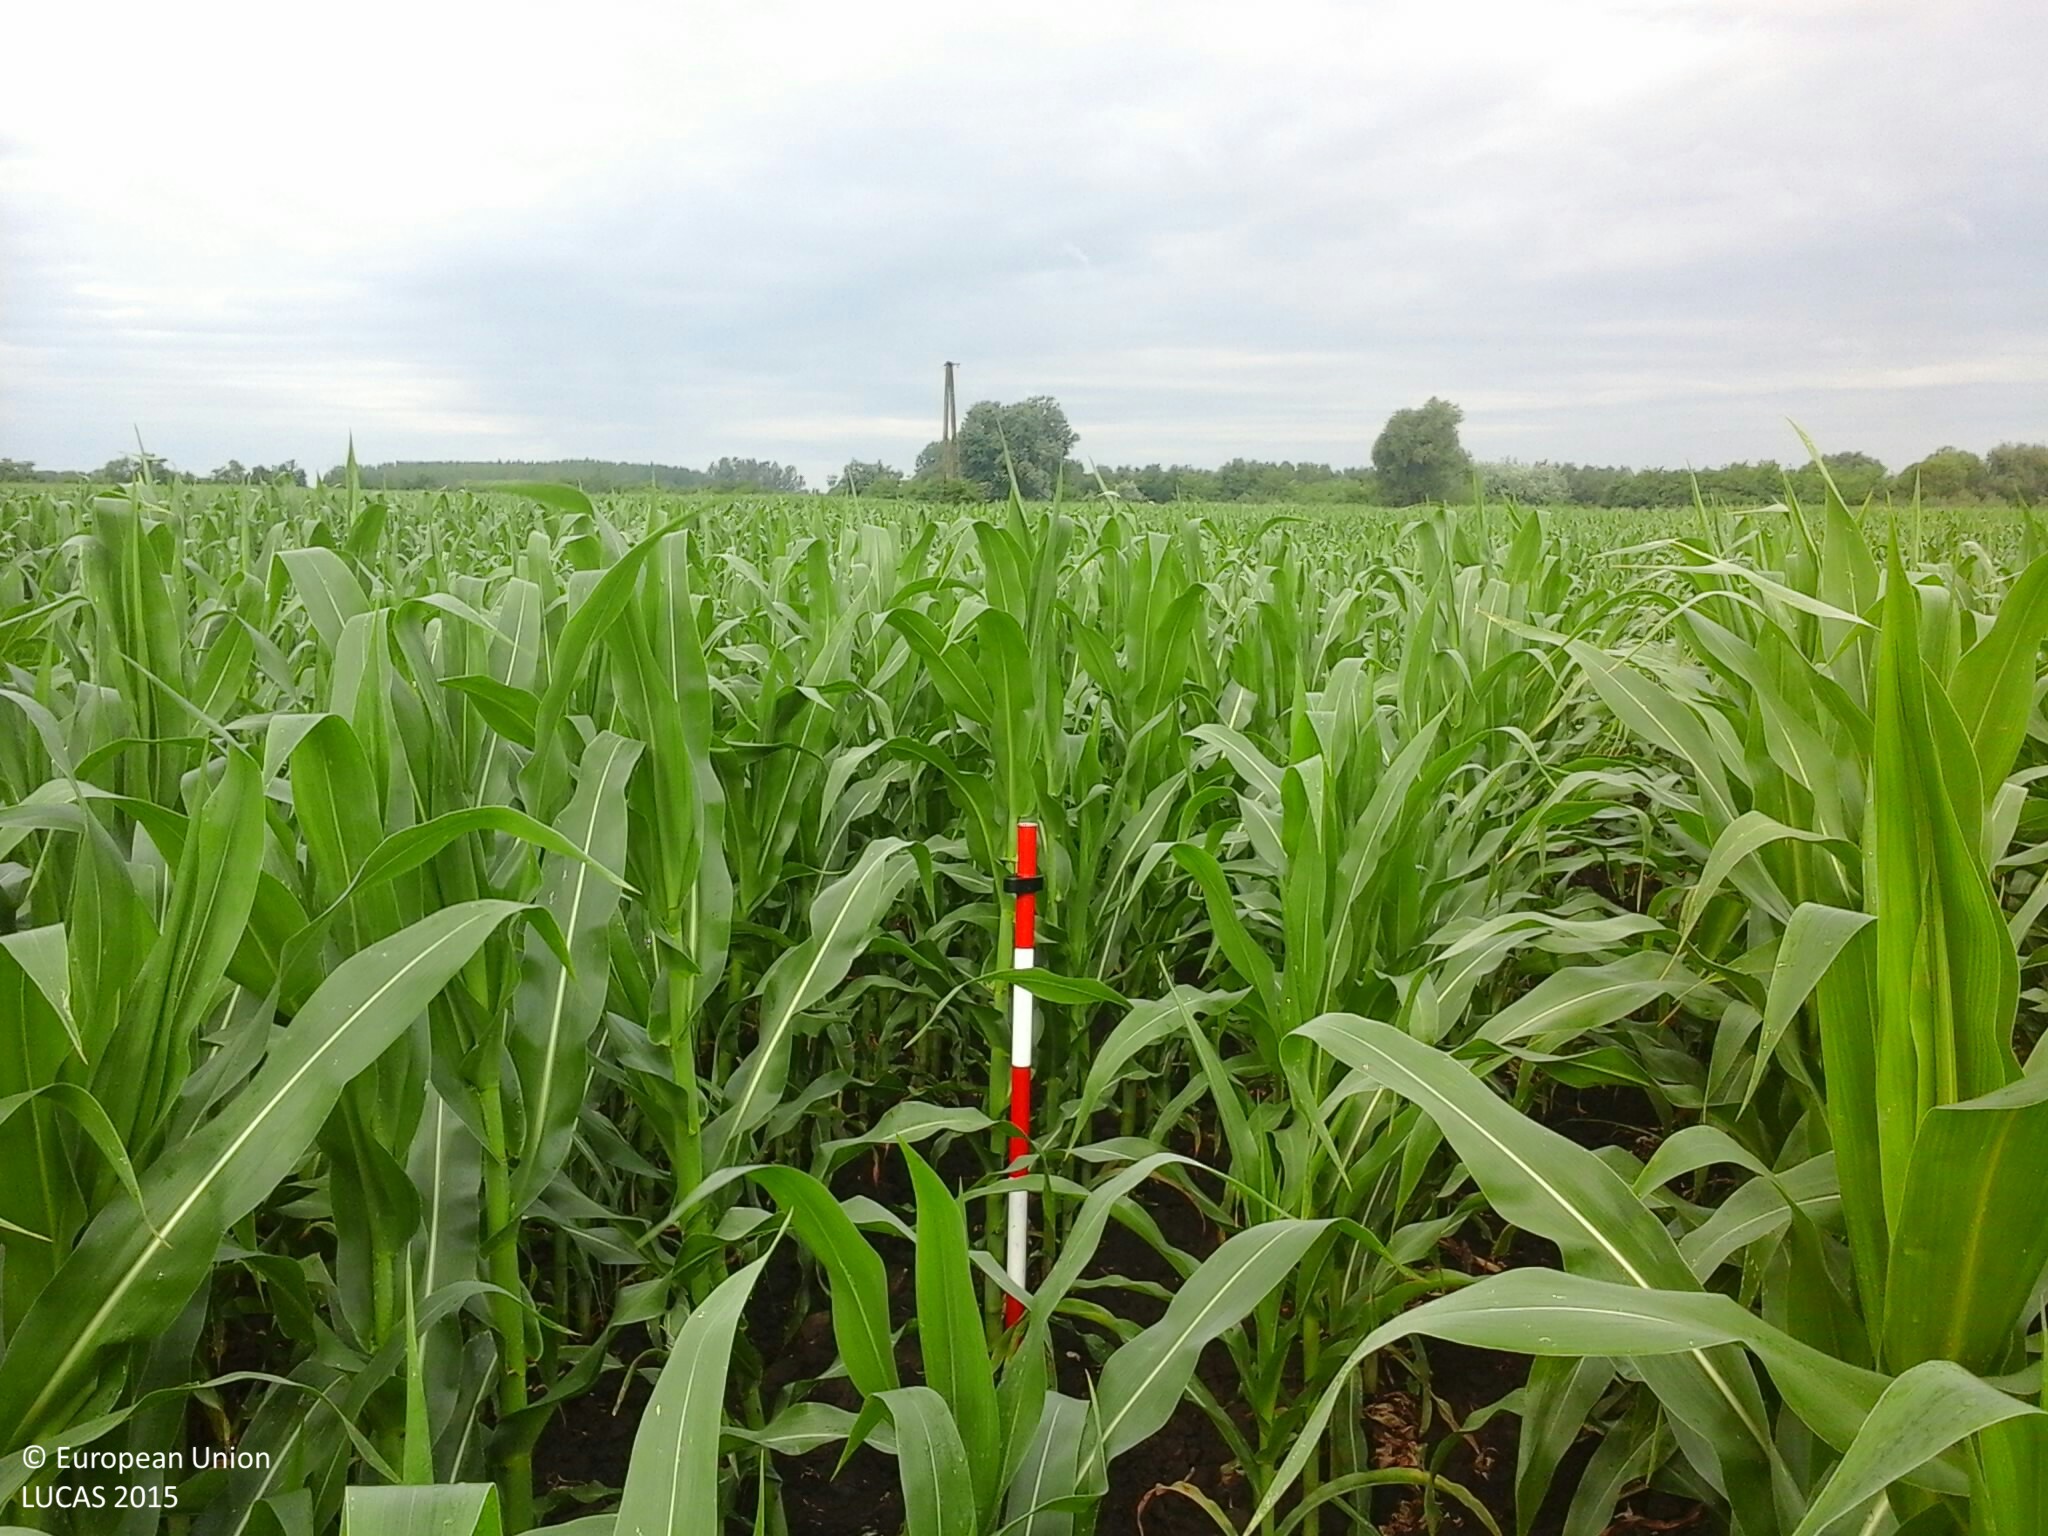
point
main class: Cropland
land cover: Maize
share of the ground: > 75 %
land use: Agriculture (excluding fallow land and kitchen gardens)
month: July
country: HU
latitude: 47.7898
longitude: 21.9439
